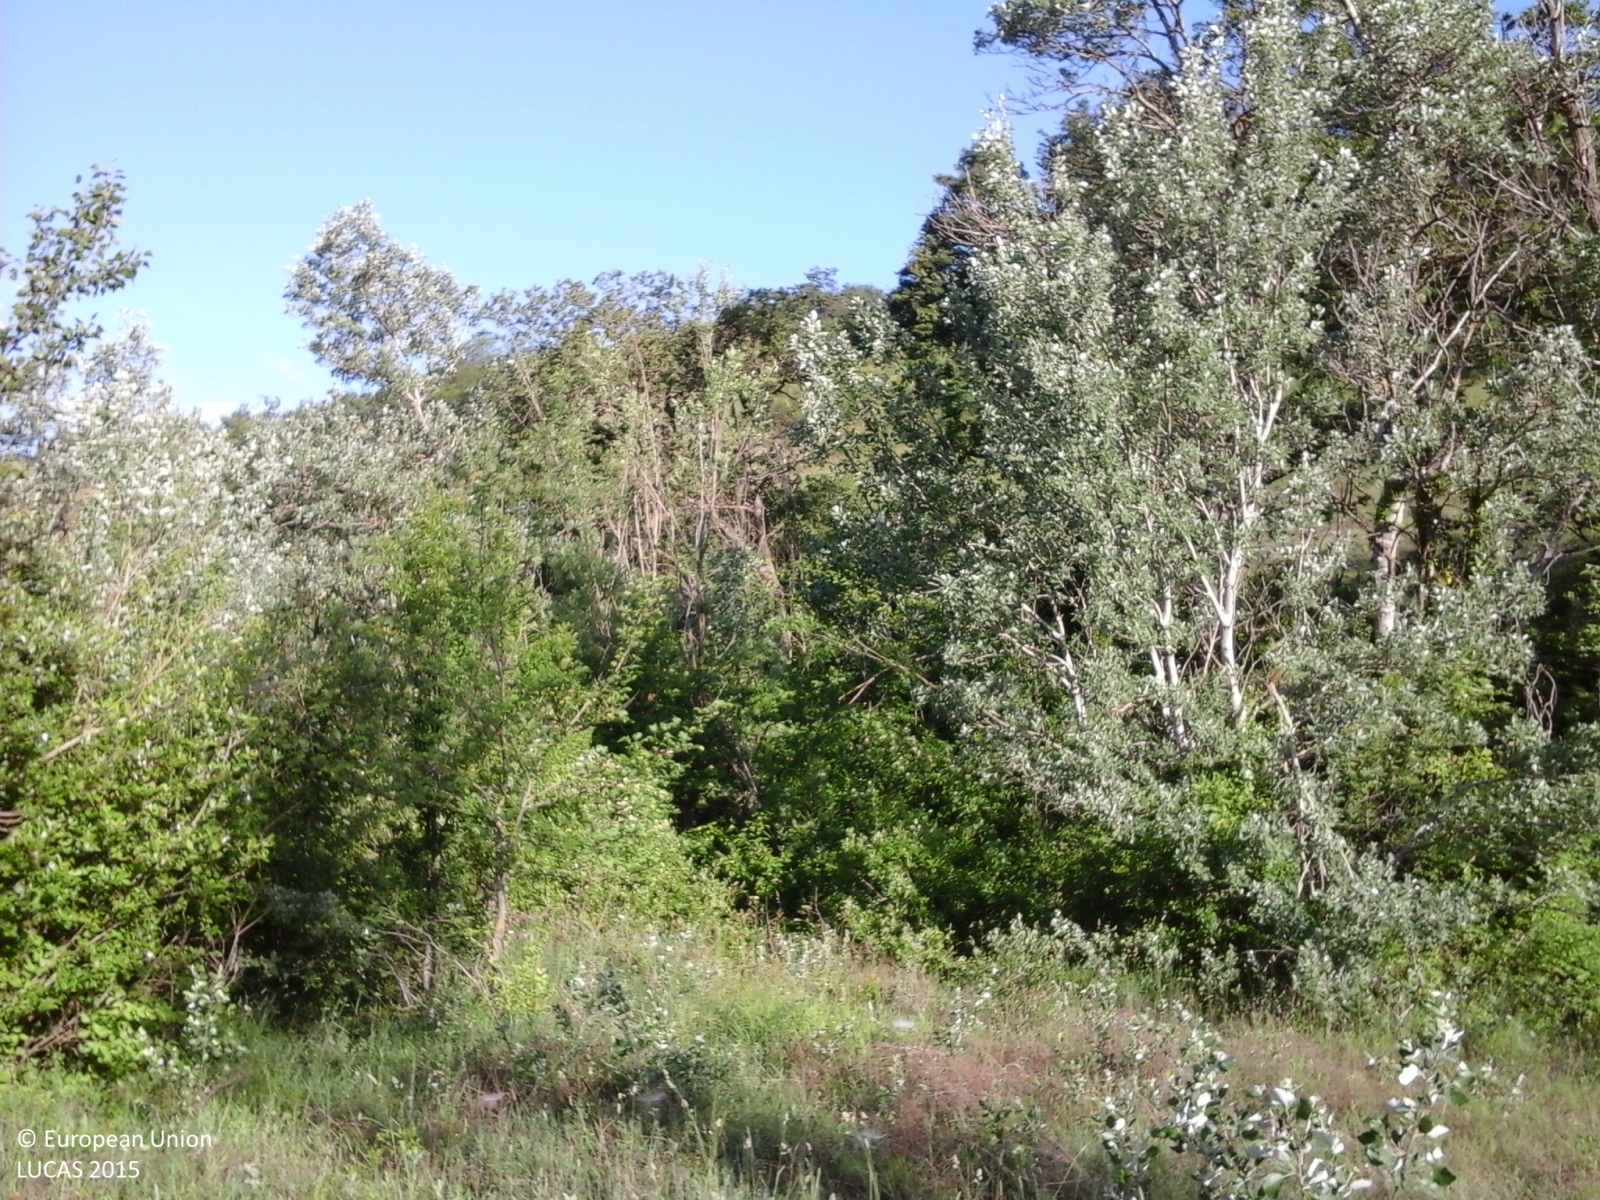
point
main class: Woodland
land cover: Broadleaved woodland
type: thermophilous deciduous forest
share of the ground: 50 - 75 %
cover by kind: broadleaved forest trees 70 %, herbaceous plants 30 %
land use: Forestry
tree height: > 5 m
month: May
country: IT
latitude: 44.4742
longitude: 10.7401
